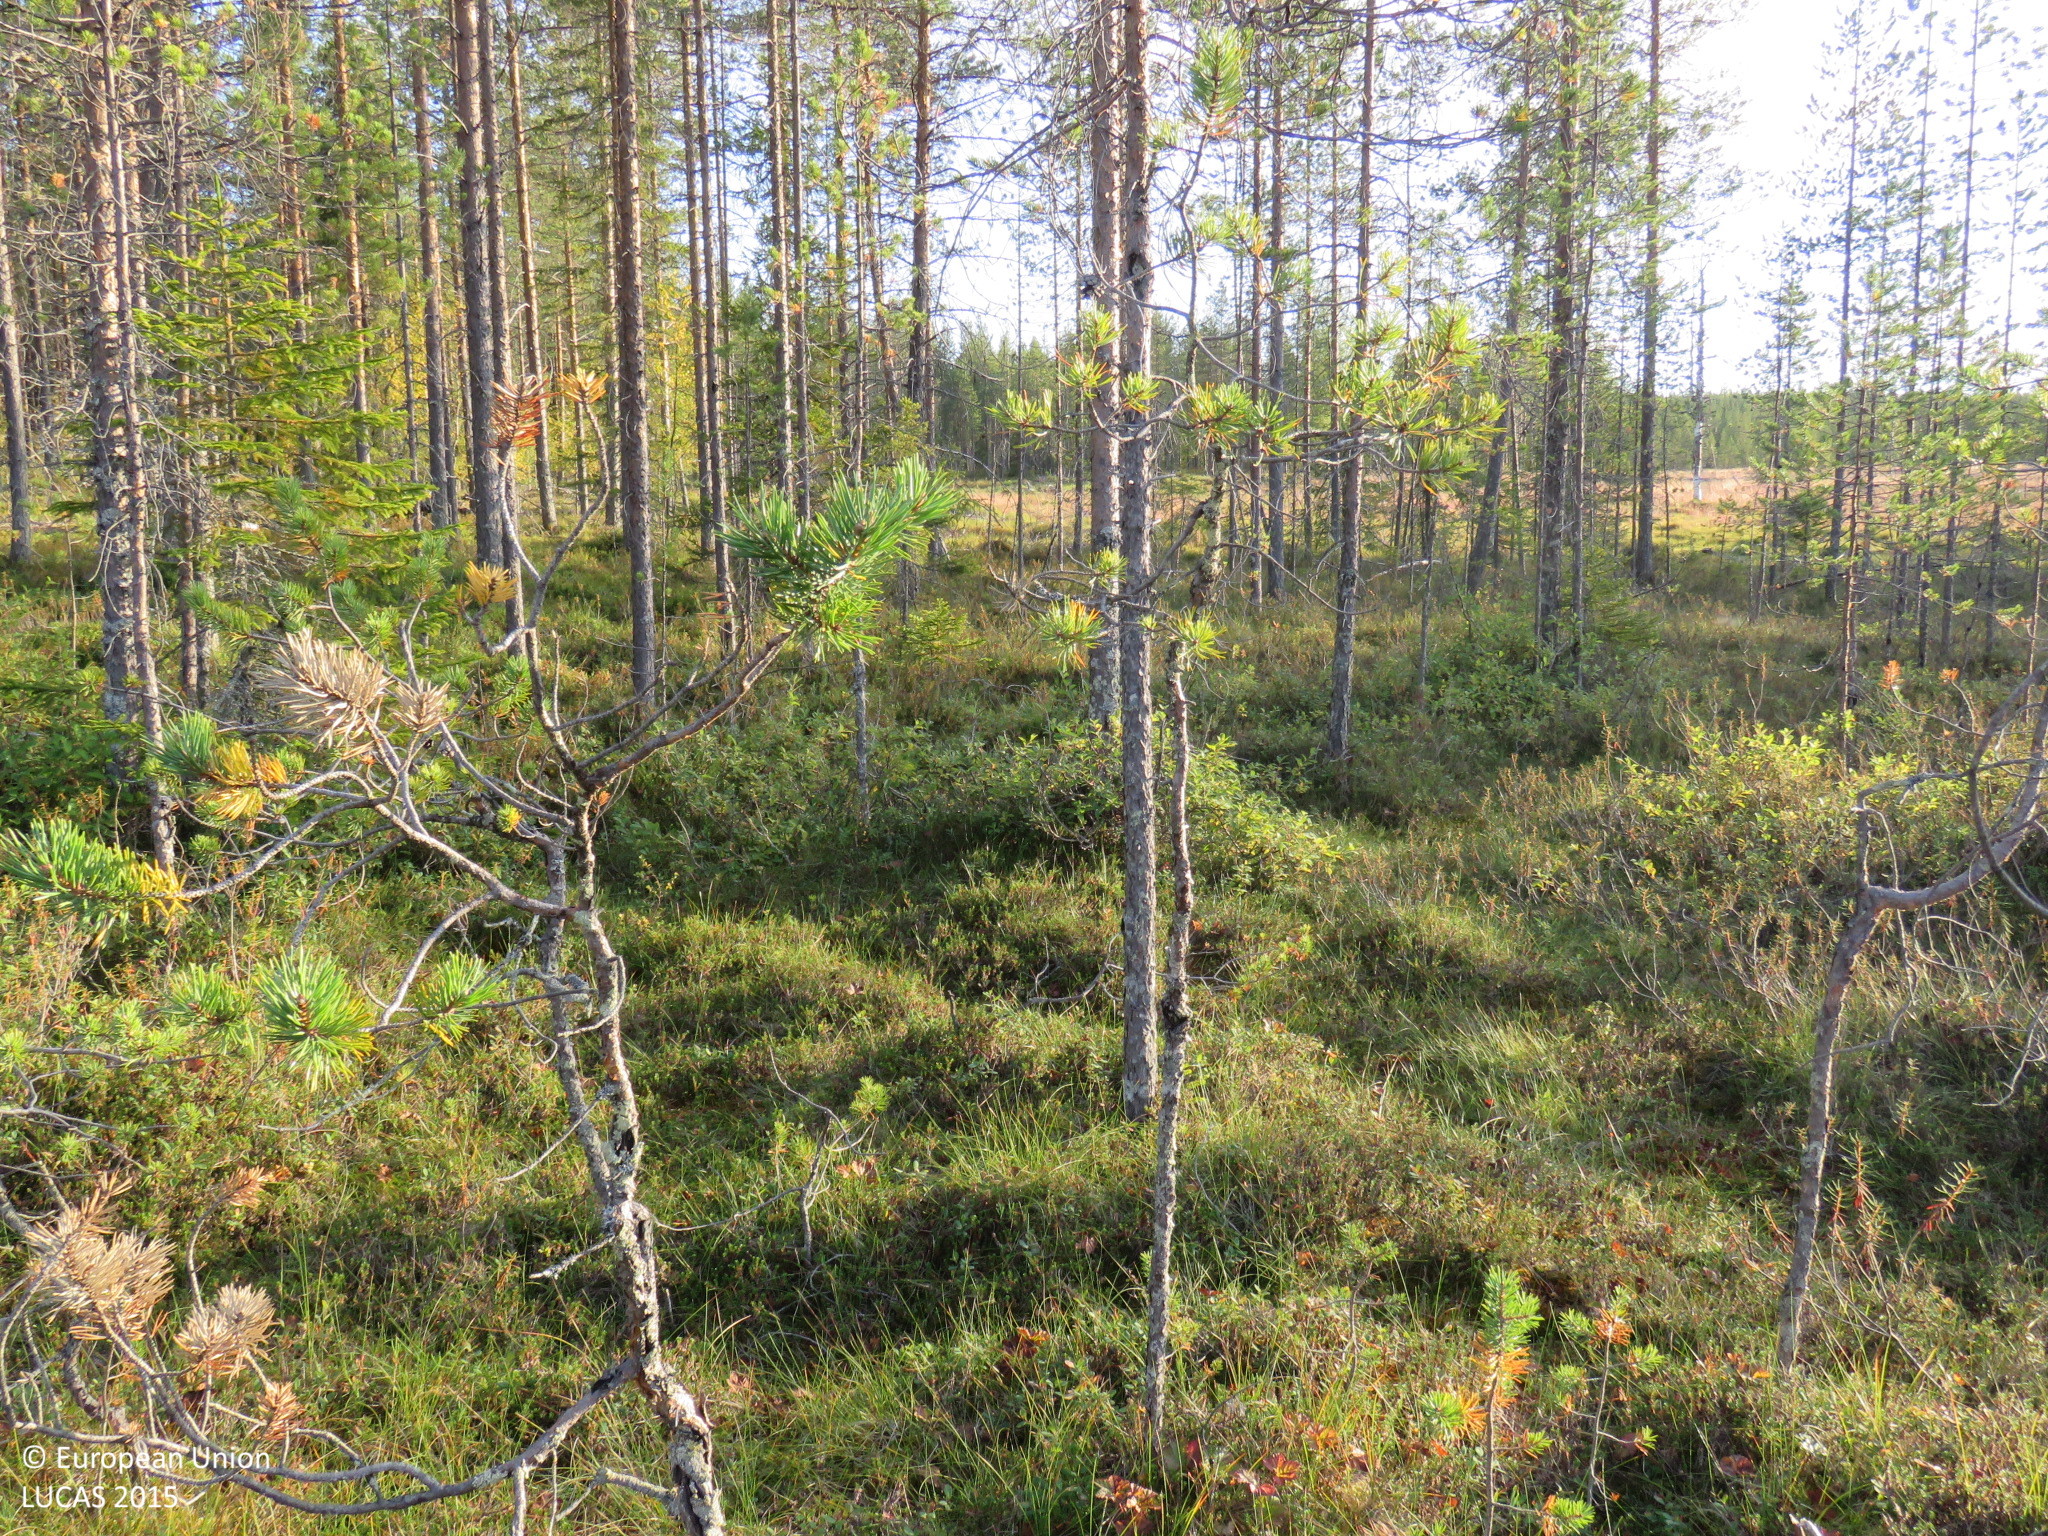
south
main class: Woodland
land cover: Pine dominated coniferous woodland
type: mire and swamp forests
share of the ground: 25 - 50 %
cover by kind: coniferous forest trees 45 %, herbaceous plants 25 %, shrubs 20 %, lichens and mosses 10 %
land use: Forestry
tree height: > 5 m
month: September
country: FI
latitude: 65.4957
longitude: 27.7026
